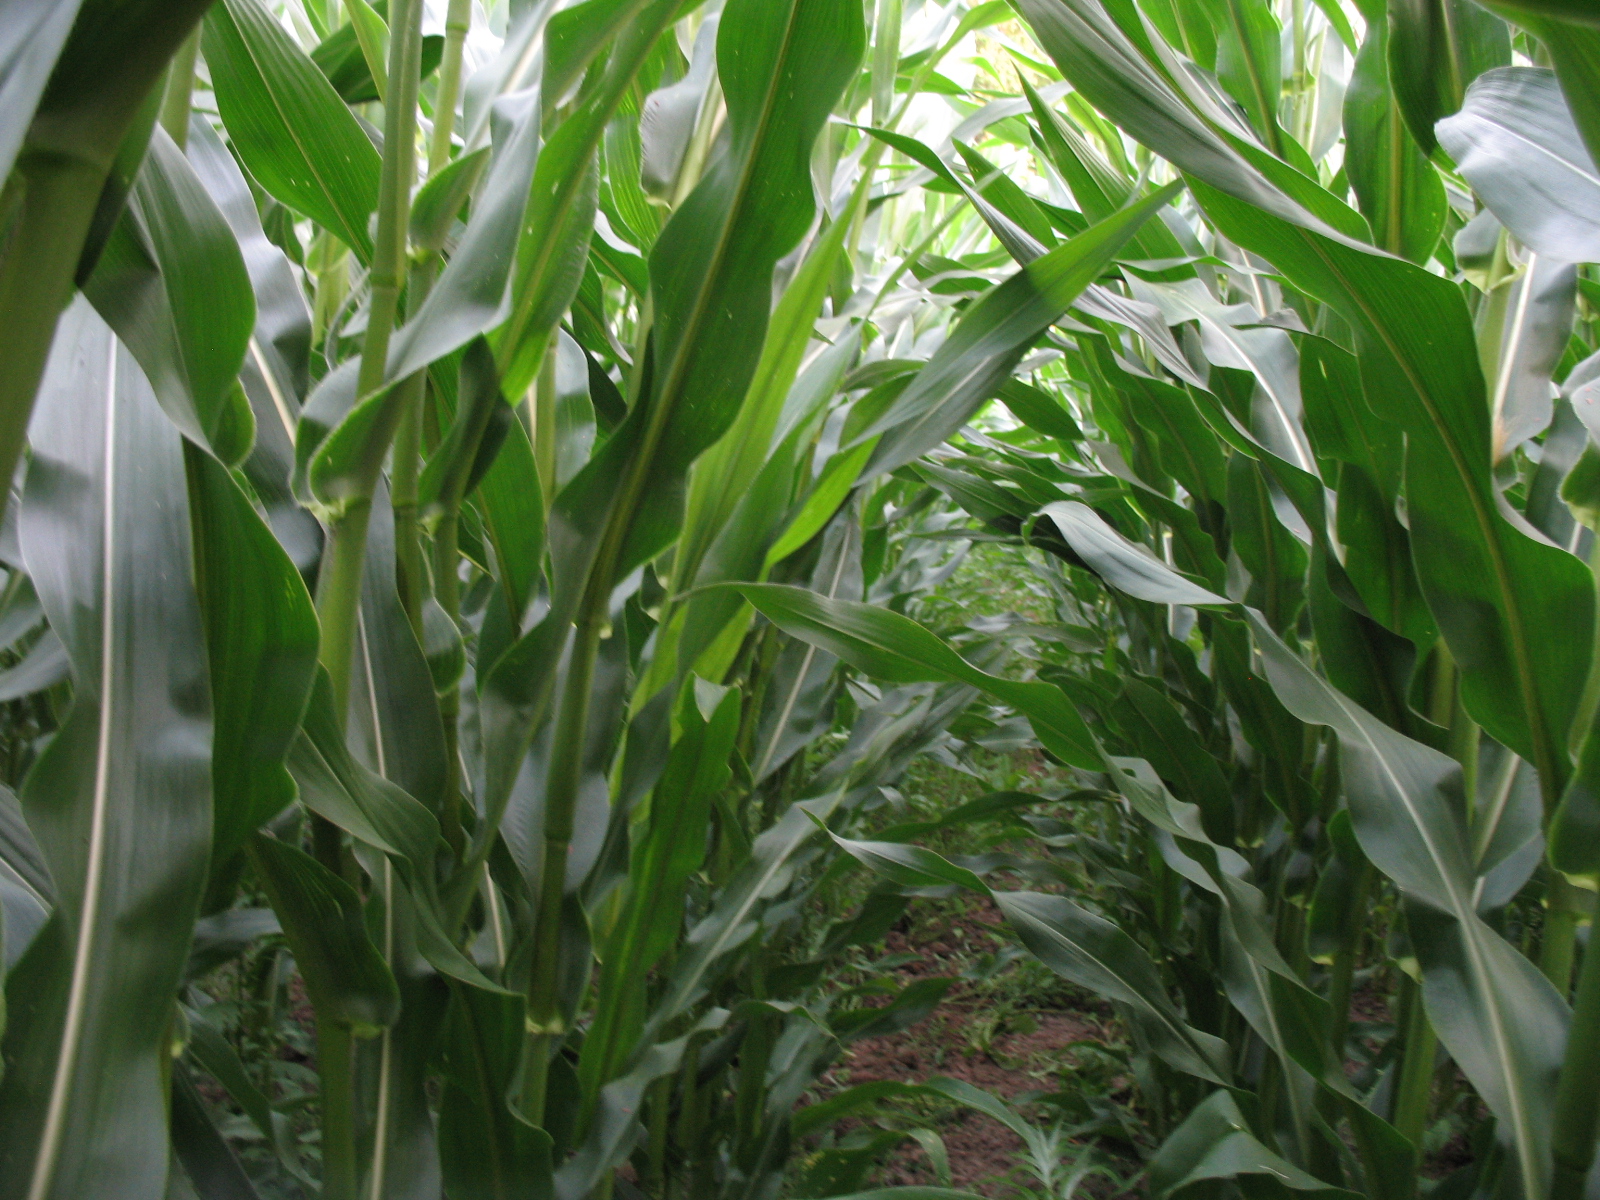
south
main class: Cropland
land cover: Maize
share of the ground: > 75 %
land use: Agriculture (excluding fallow land and kitchen gardens)
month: August
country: LV
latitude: 56.3594
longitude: 25.4803
